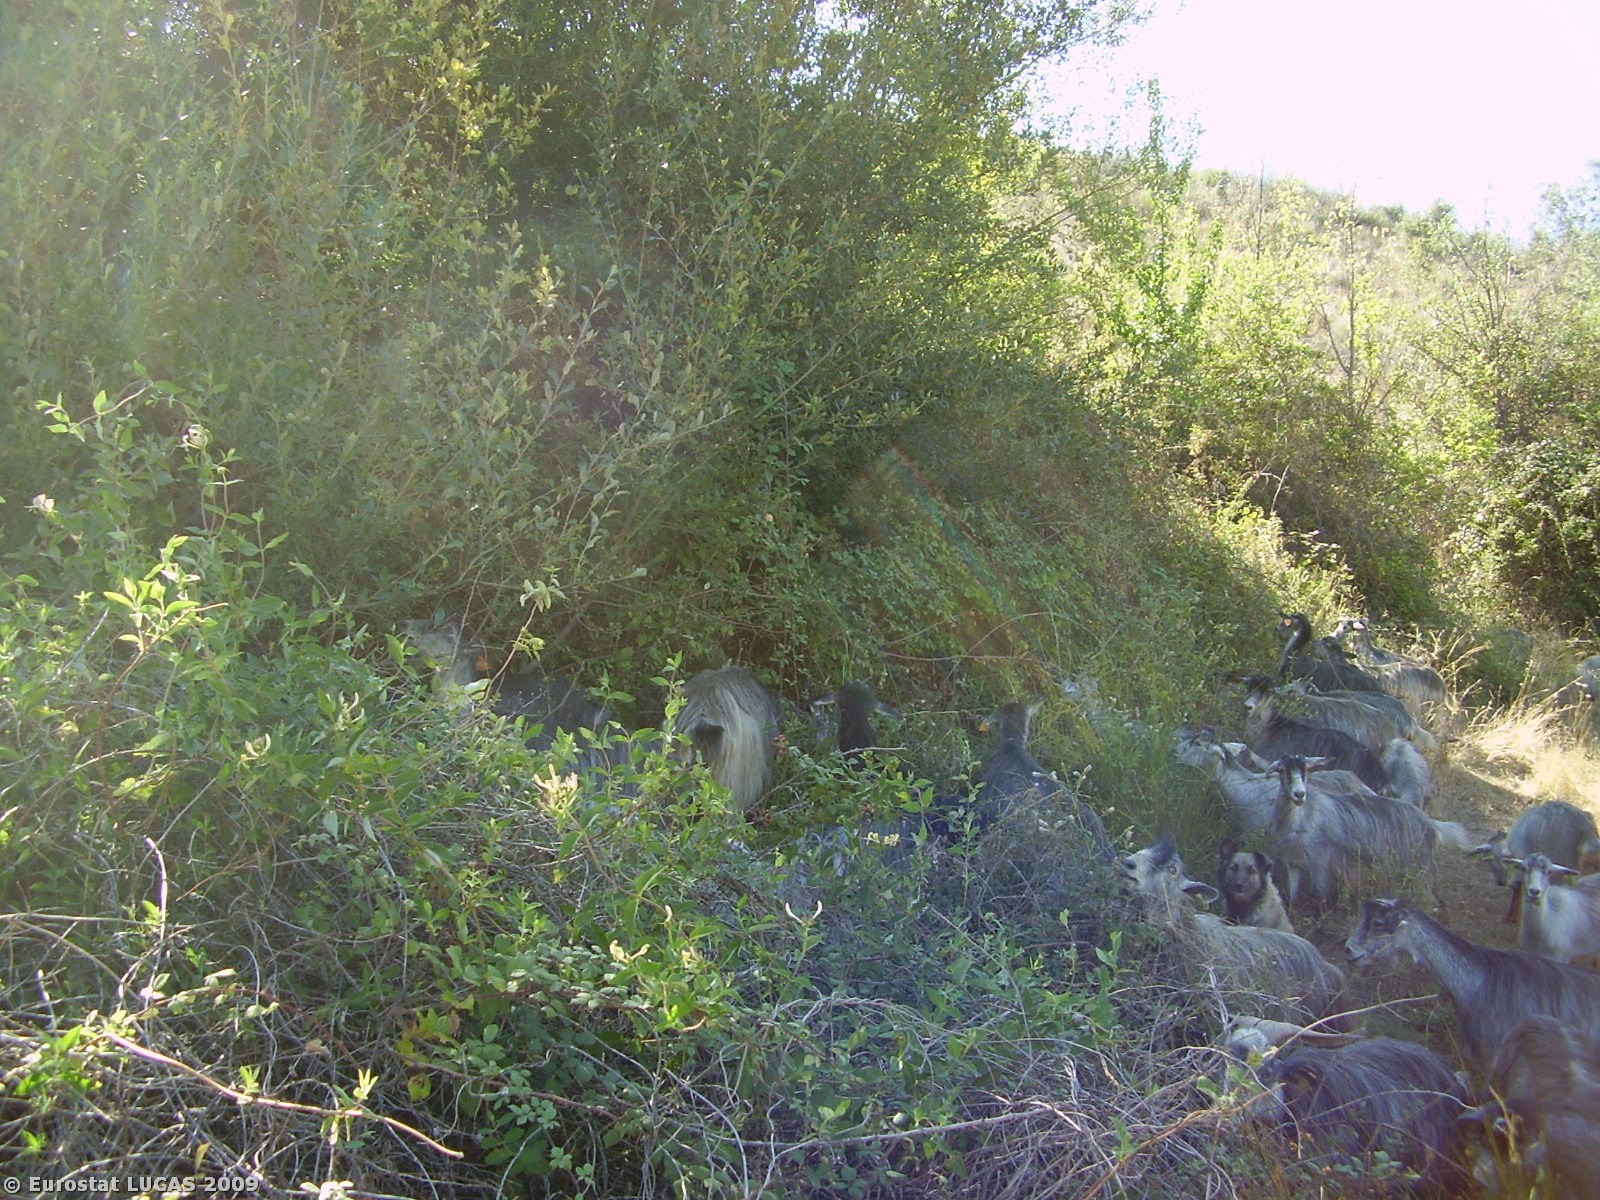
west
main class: Grassland
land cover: Spontaneously vegetated surfaces
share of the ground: > 75 %
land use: Fallow land
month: August
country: PT
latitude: 41.2784
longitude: -6.7846
